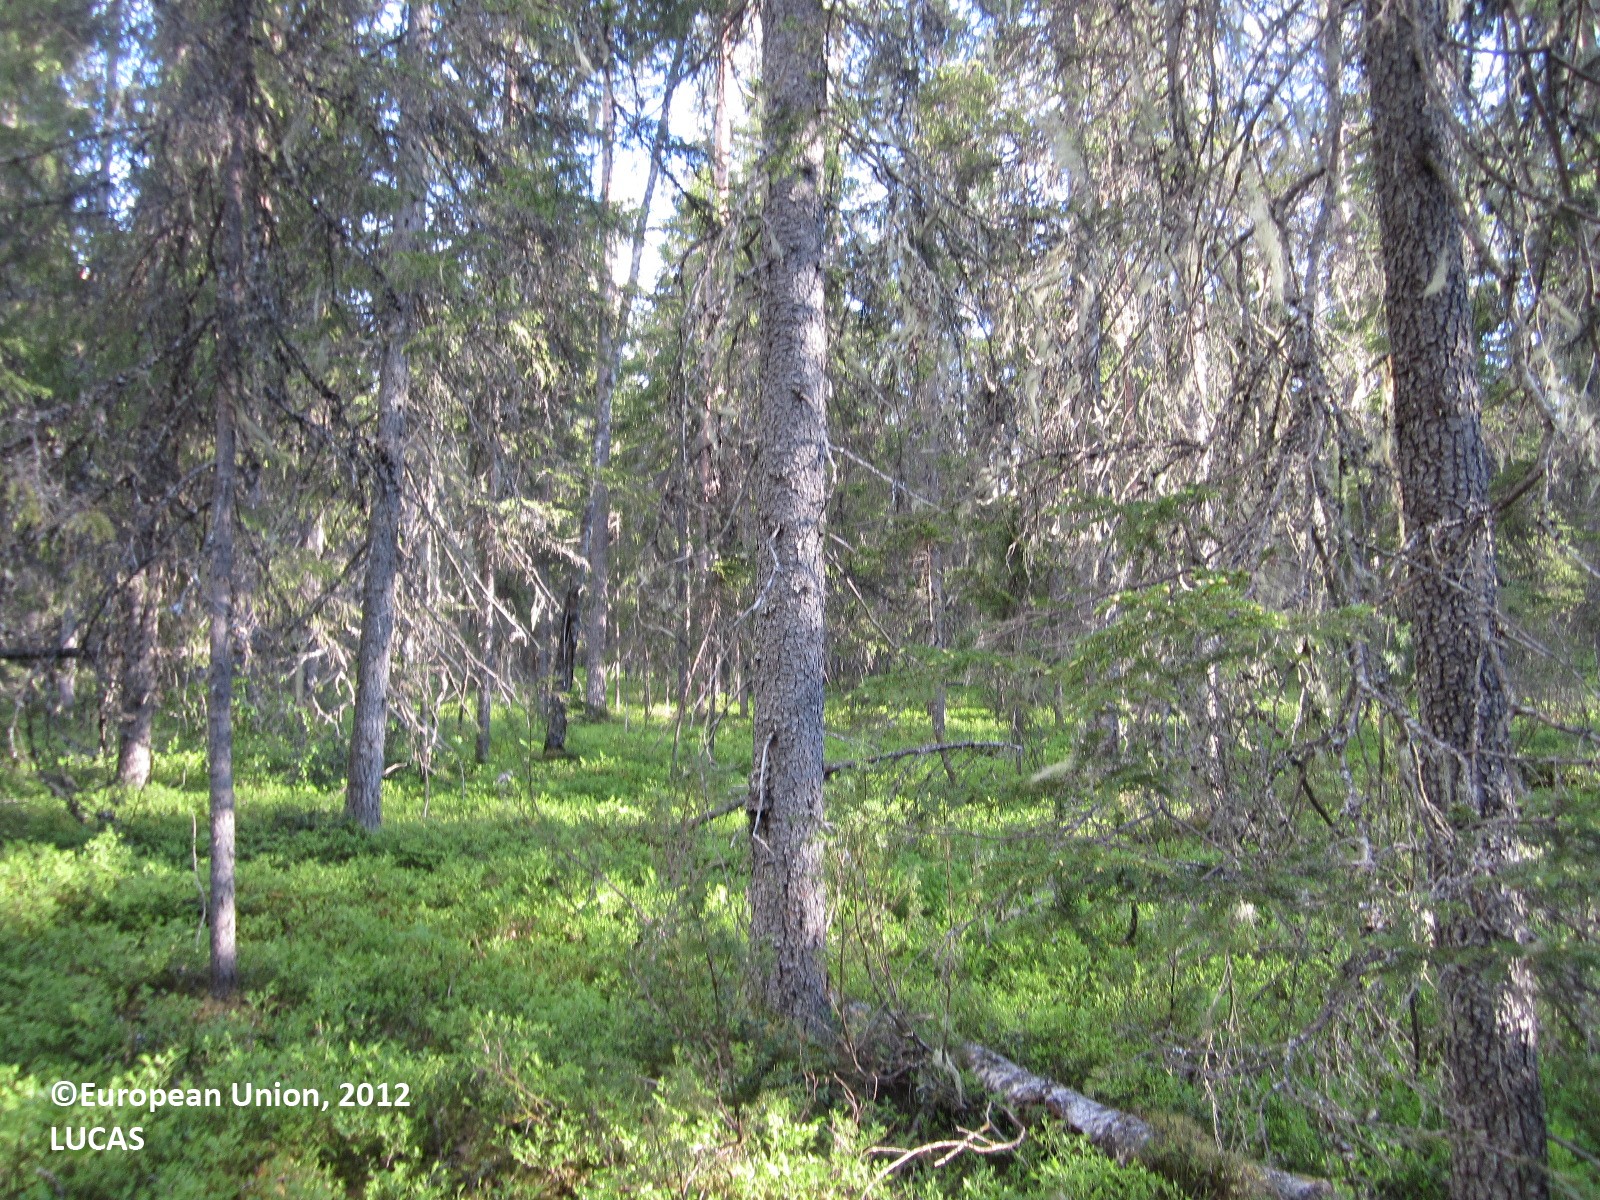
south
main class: Woodland
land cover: Spruce dominated coniferous woodland
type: boreal forest
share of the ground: > 75 %
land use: Forestry
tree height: > 5 m
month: June
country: FI
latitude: 64.7036
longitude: 28.7444
